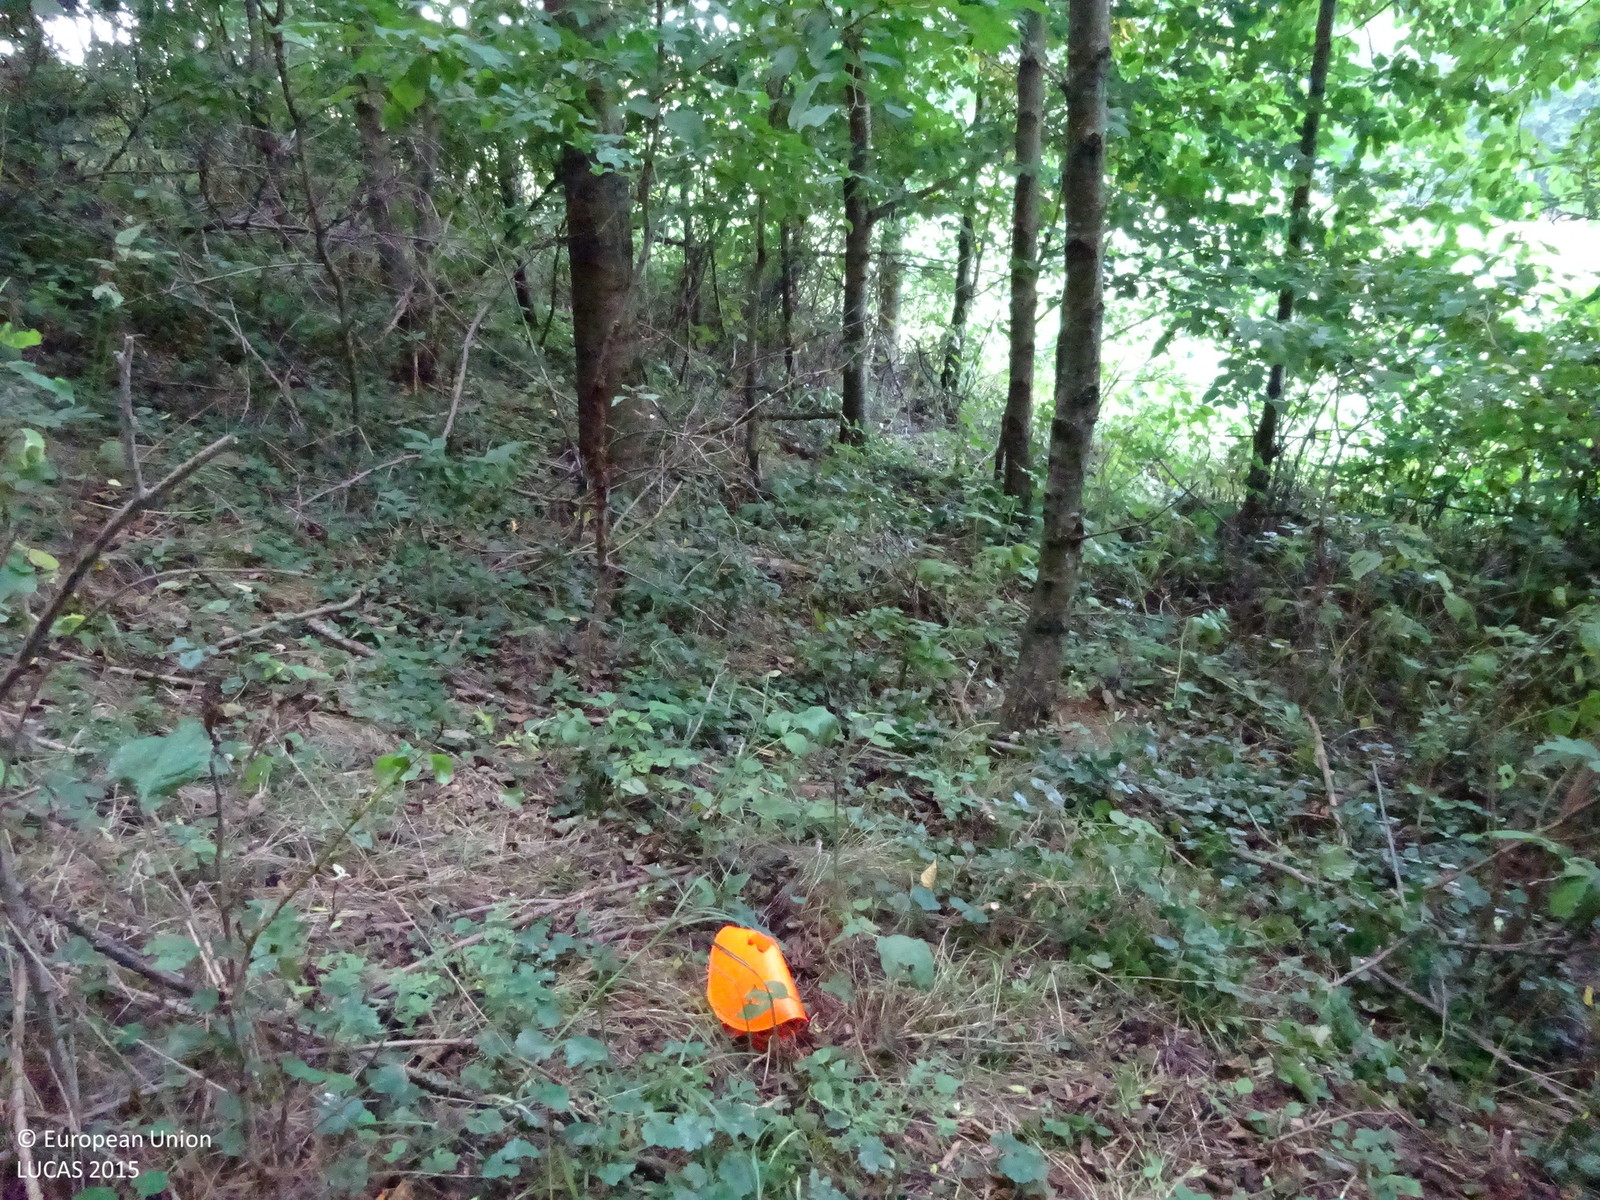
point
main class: Woodland
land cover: Broadleaved woodland
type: hemiboreal forest and nemoral coniferous forest and mixed broadleaved-coniferous forest
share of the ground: > 75 %
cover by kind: broadleaved forest trees 80 %, herbaceous plants 20 %
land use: Forestry
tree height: > 5 m
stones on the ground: < 10 %
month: August
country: AT
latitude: 47.3772
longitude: 15.9485
